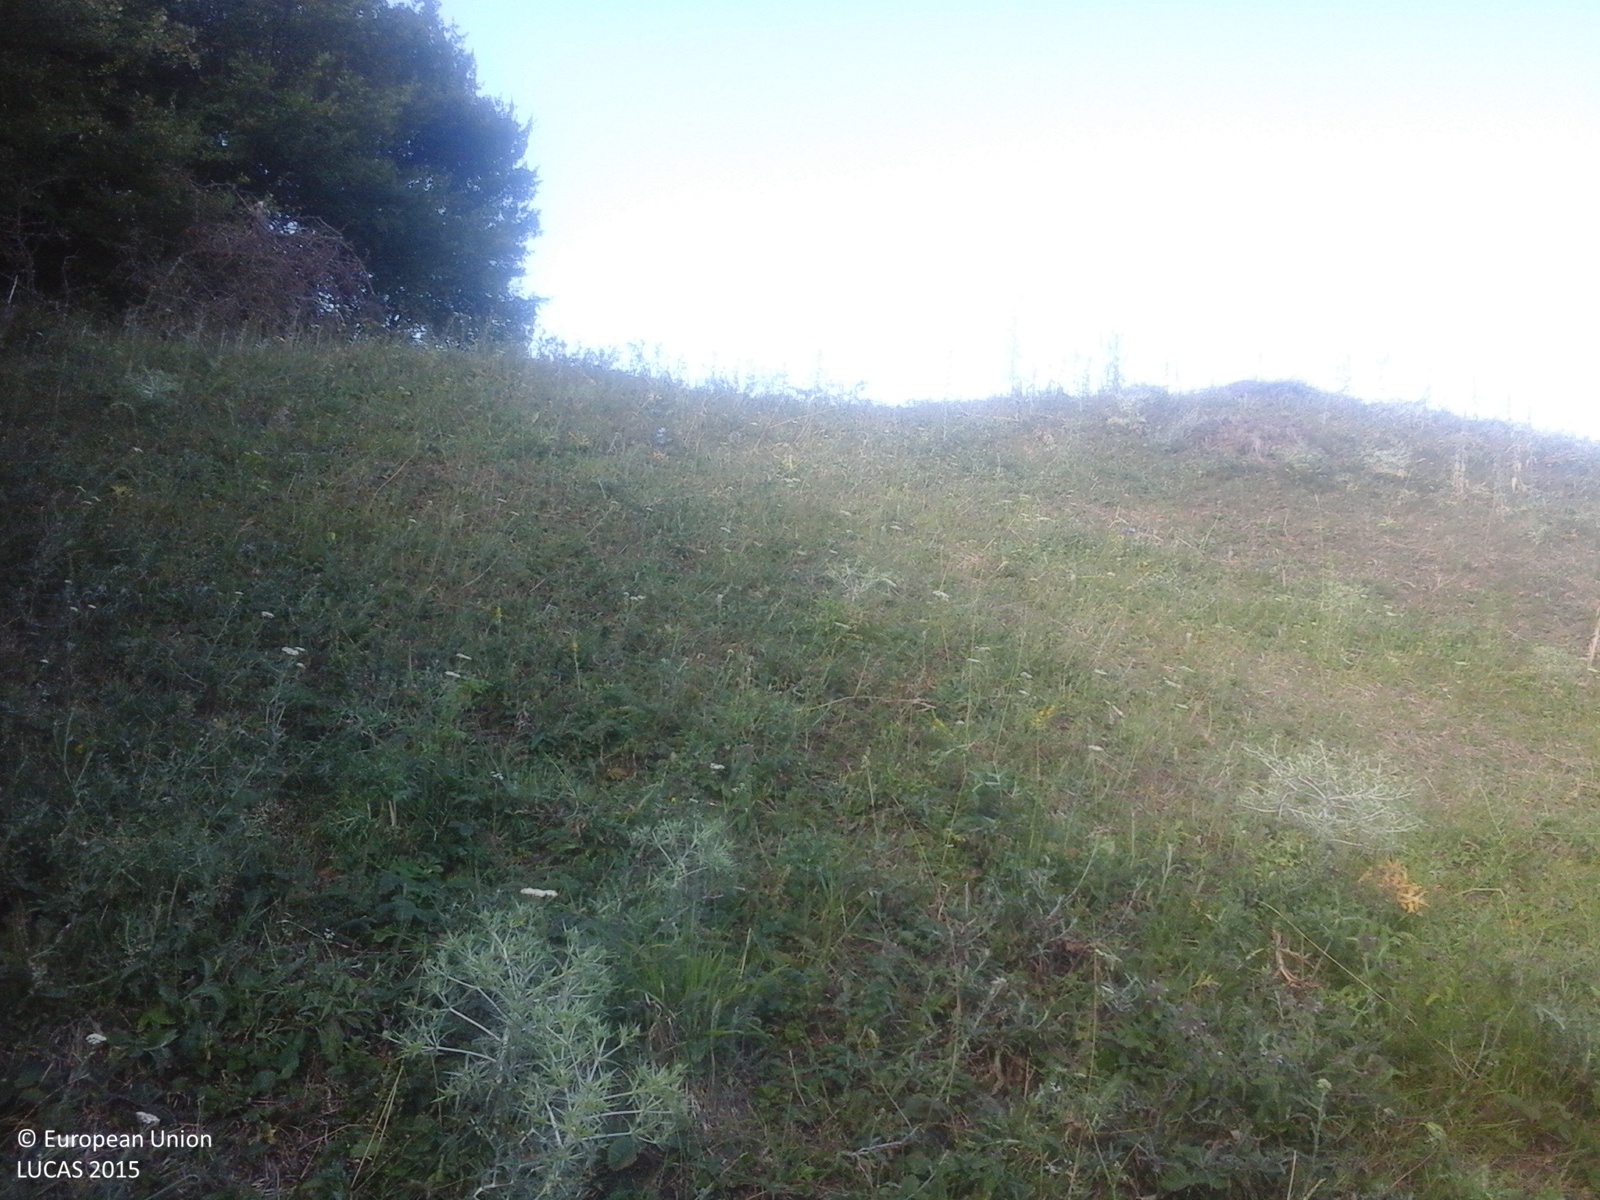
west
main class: Grassland
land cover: Grassland with sparse tree/shrub cover
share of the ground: > 75 %
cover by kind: herbaceous plants 85 %, shrubs 10 %, broadleaved forest trees 5 %
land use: Agriculture (excluding fallow land and kitchen gardens)
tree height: < 5 m
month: July
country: RO
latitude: 46.6053
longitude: 27.9462
